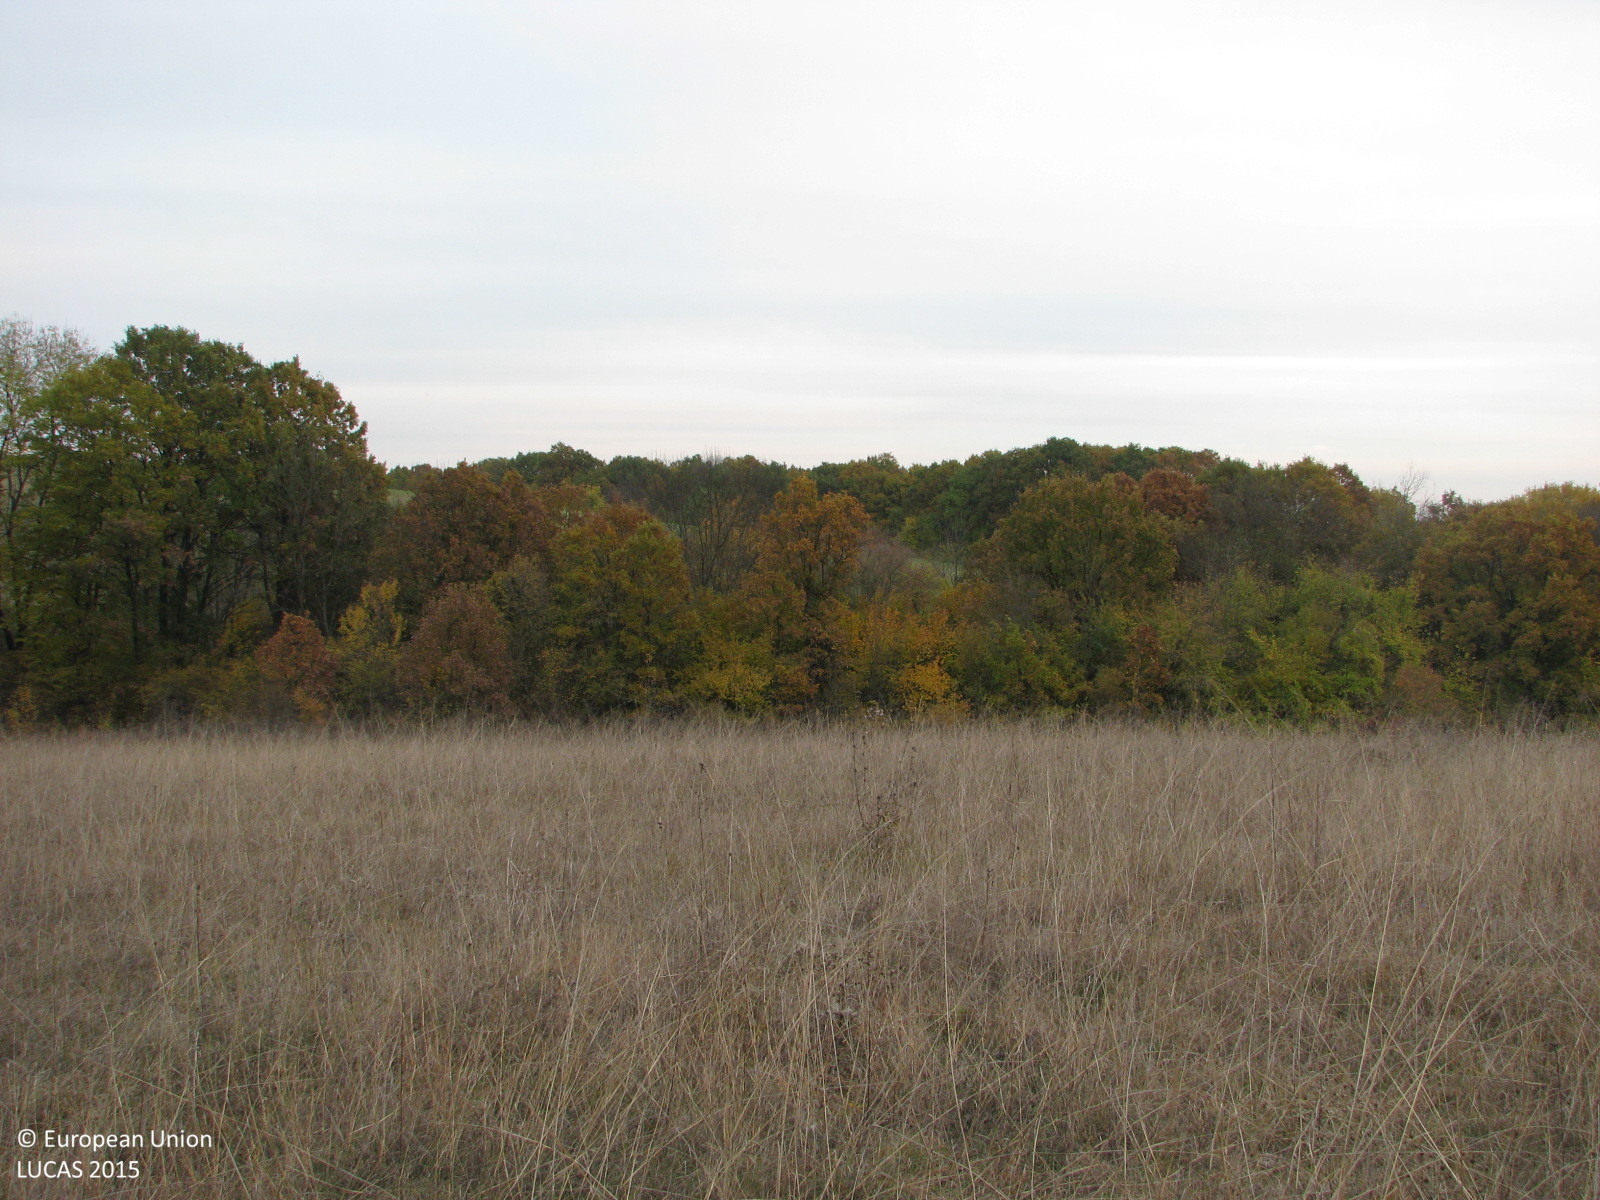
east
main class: Grassland
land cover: Grassland with sparse tree/shrub cover
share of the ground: > 75 %
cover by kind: herbaceous plants 90 %, broadleaved forest trees 5 %, shrubs 5 %
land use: Agriculture (excluding fallow land and kitchen gardens)
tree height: < 5 m
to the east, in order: Grassland with sparse tree/shrub cover; Grassland without tree/shrub cover; Broadleaved woodland; Rivers and streams; Broadleaved woodland; Grass margins; Common wheat
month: November
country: BG
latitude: 42.0551
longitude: 26.4335
